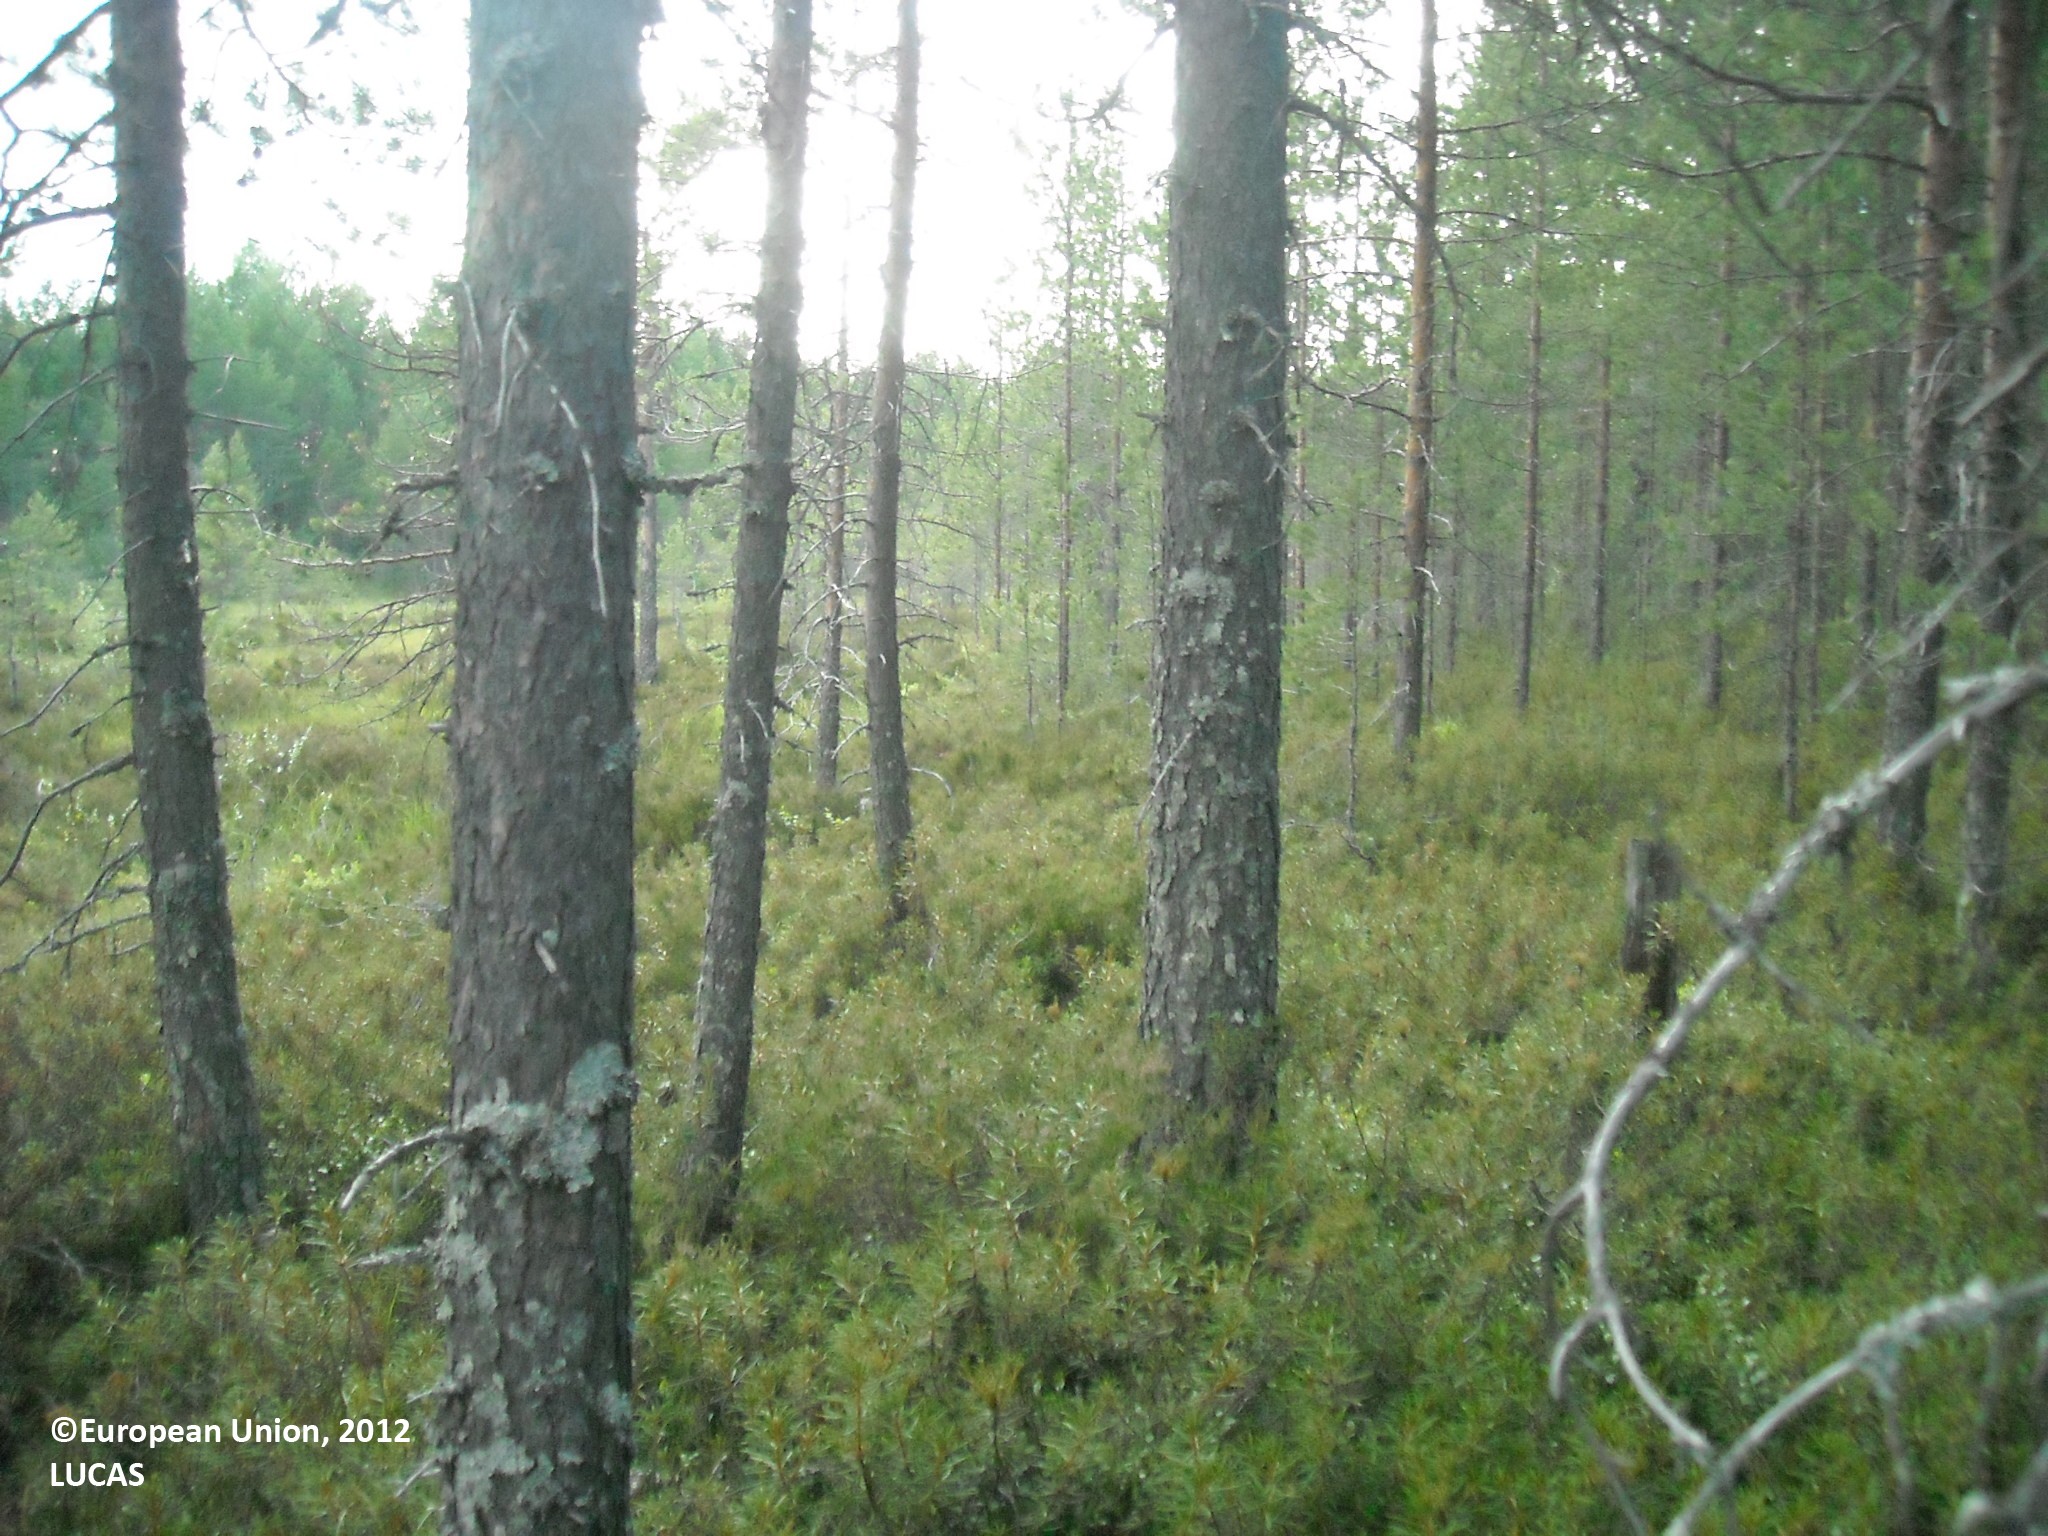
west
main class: Woodland
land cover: Pine dominated coniferous woodland
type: mire and swamp forests
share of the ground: 50 - 75 %
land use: Forestry
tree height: > 5 m
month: July
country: FI
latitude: 65.0703
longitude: 26.8065
